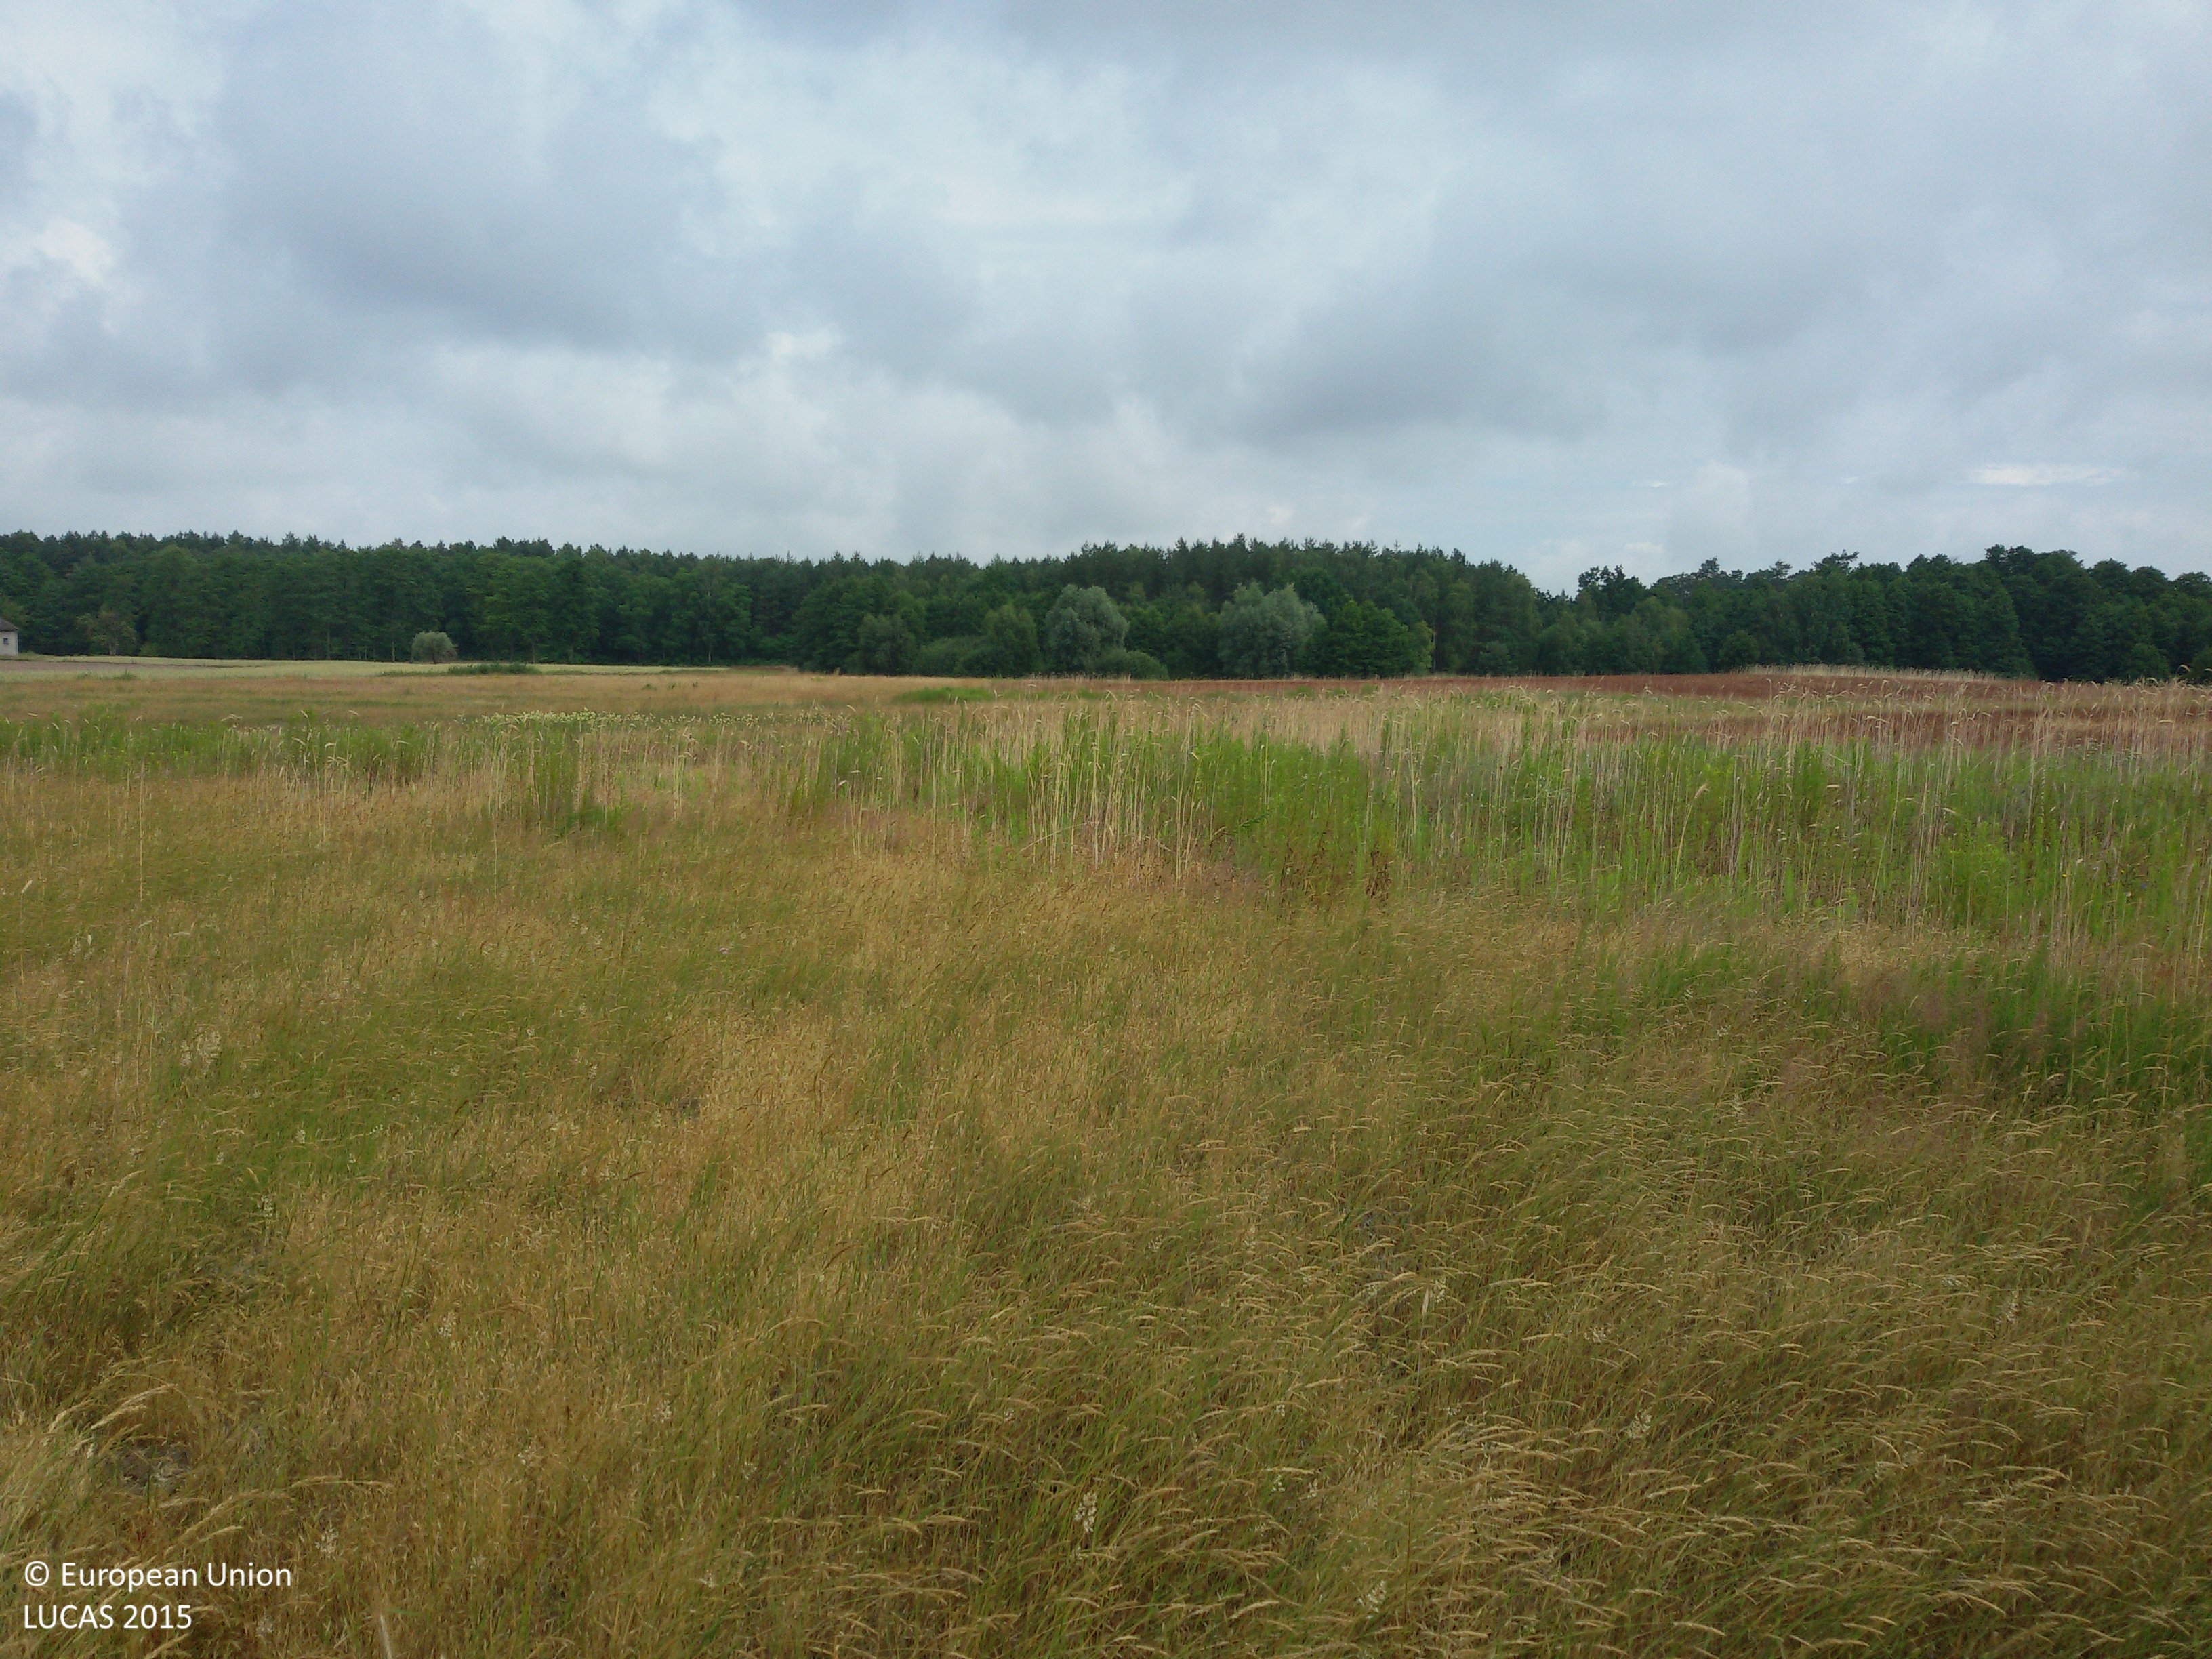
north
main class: Grassland
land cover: Grassland without tree/shrub cover
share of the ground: > 75 %
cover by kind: herbaceous plants 95 %, shrubs 5 %
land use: Agriculture (excluding fallow land and kitchen gardens)
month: July
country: PL
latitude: 52.6995
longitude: 19.0650
